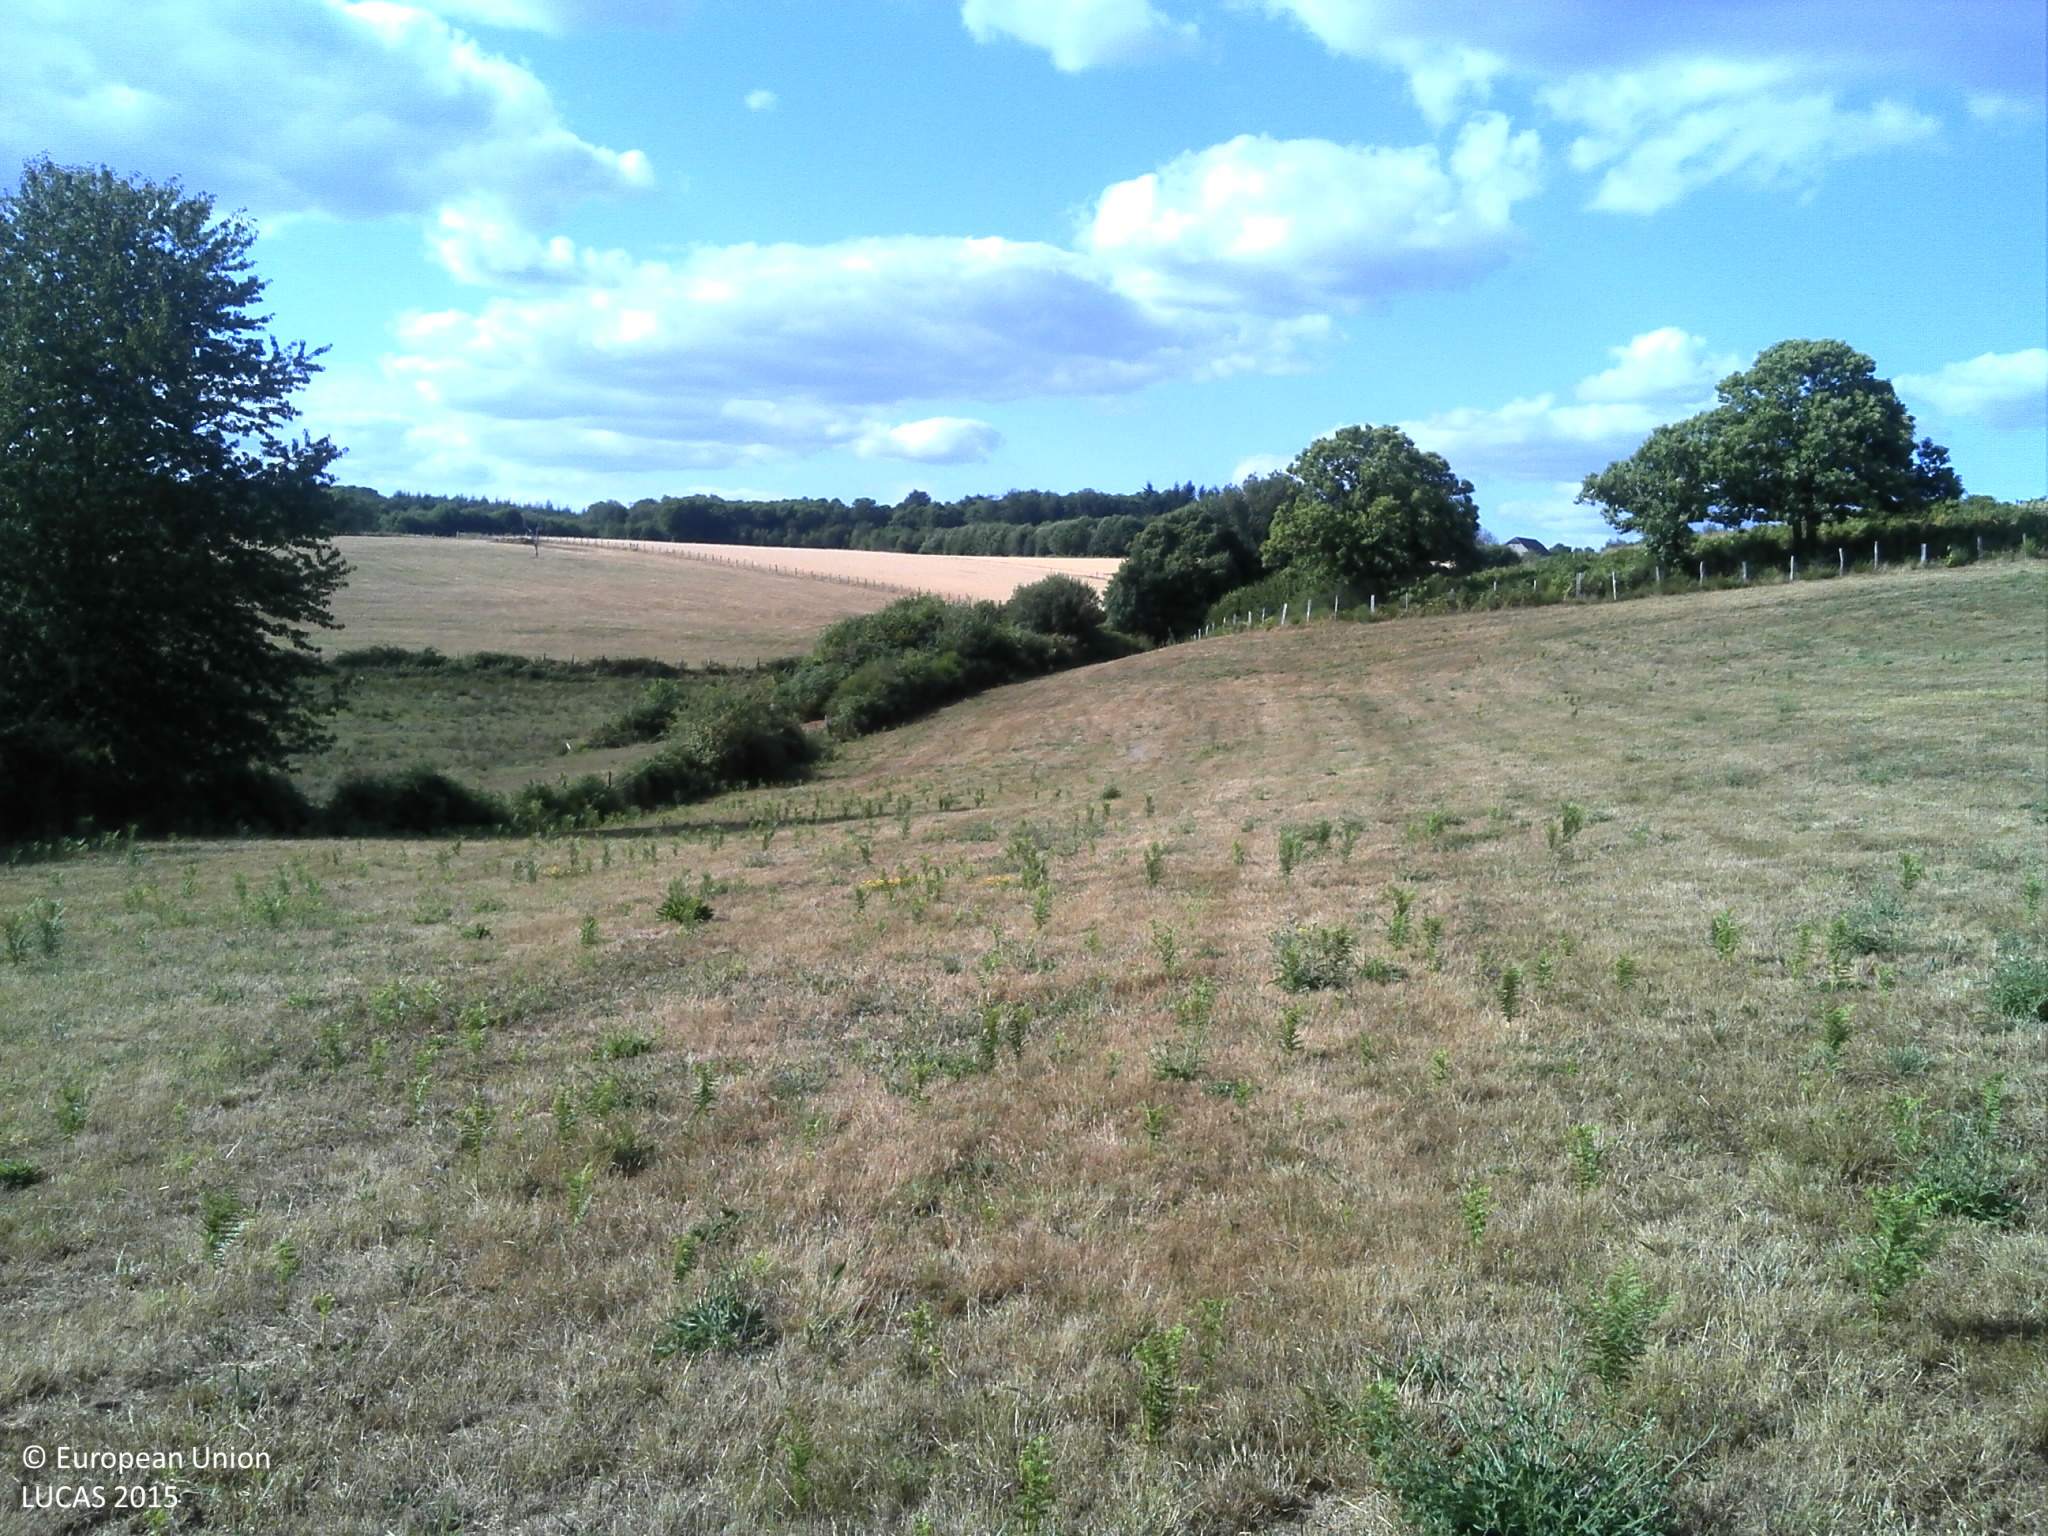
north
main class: Grassland
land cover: Grassland without tree/shrub cover
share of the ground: > 75 %
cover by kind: herbaceous plants 100 %
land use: Agriculture (excluding fallow land and kitchen gardens)
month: July
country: FR
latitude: 45.1801
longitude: 1.7372
